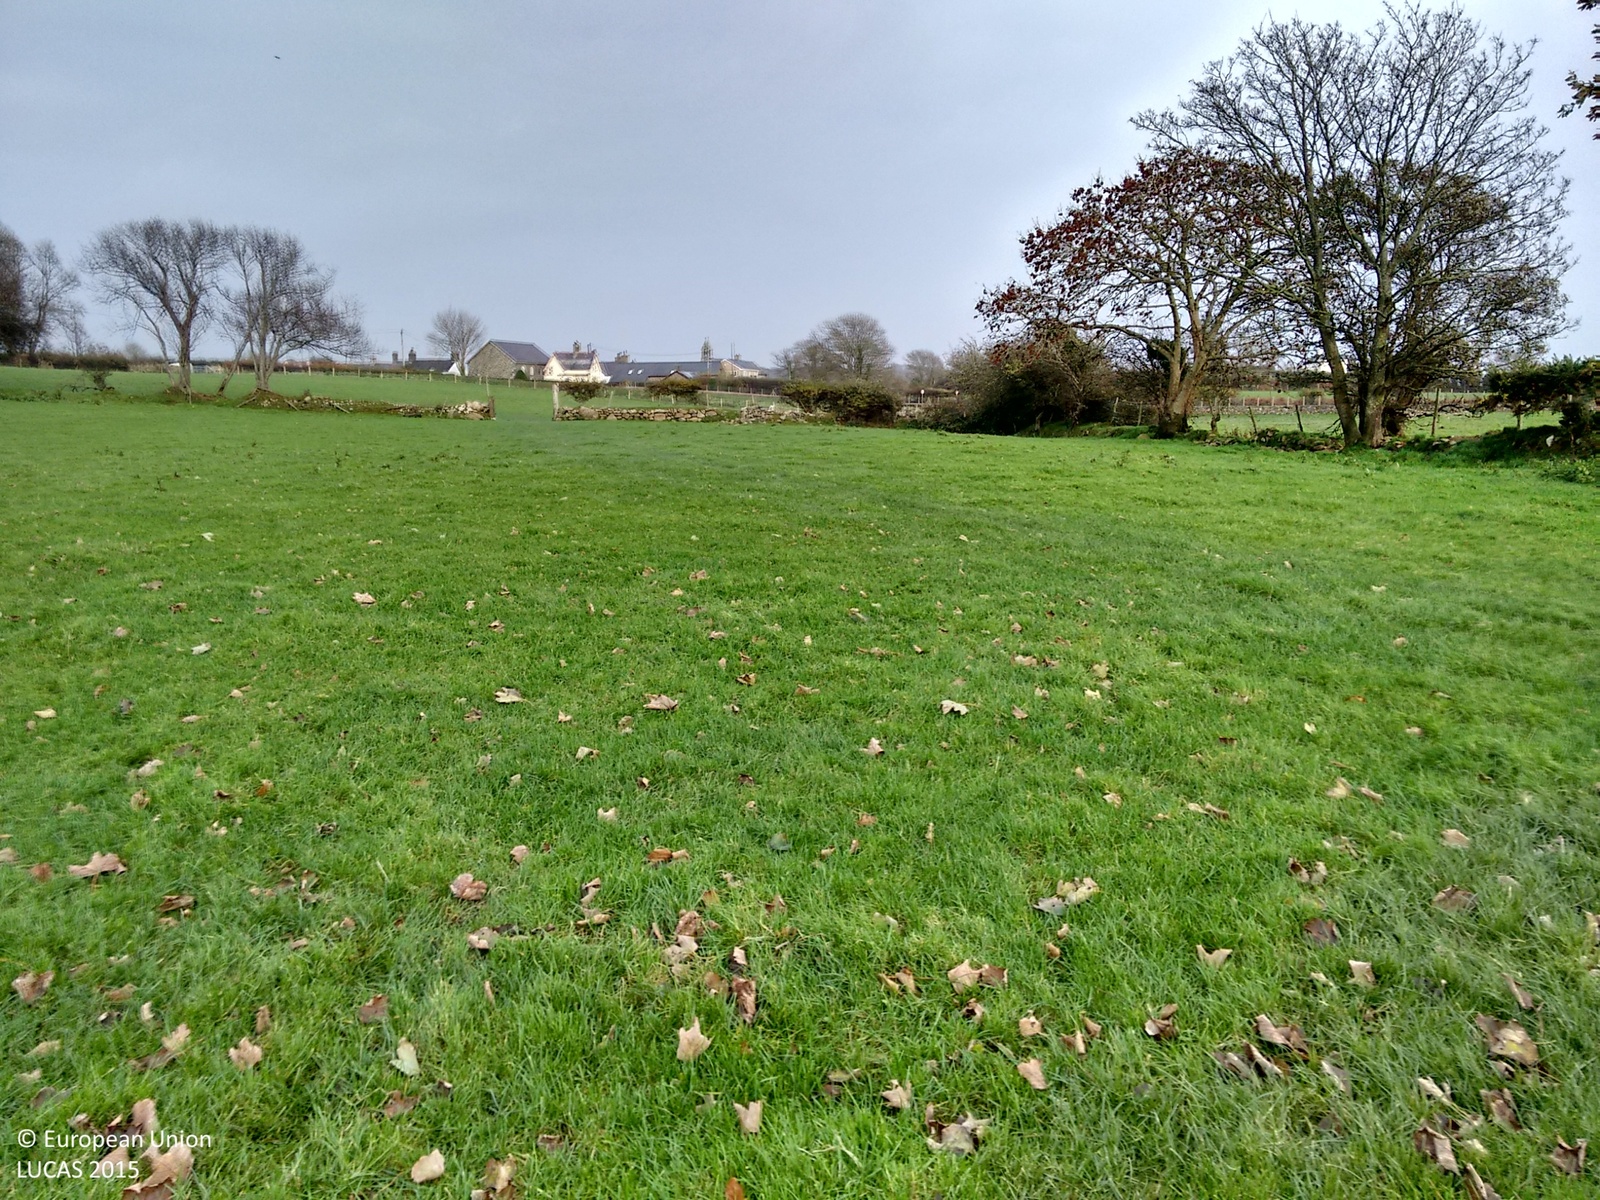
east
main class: Grassland
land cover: Grassland without tree/shrub cover
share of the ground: > 75 %
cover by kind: herbaceous plants 100 %
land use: Agriculture (excluding fallow land and kitchen gardens)
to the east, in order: Grassland without tree/shrub cover; Abandoned hedges; Dry stone walls; Fences; Grassland without tree/shrub cover; Artificial constructions; Fences; Paved roads, cycling and walking lanes; Grass margins; Abandoned hedges; Fences; Grassland without tree/shrub cover
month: November
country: GB
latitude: 52.9018
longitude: -4.3898
